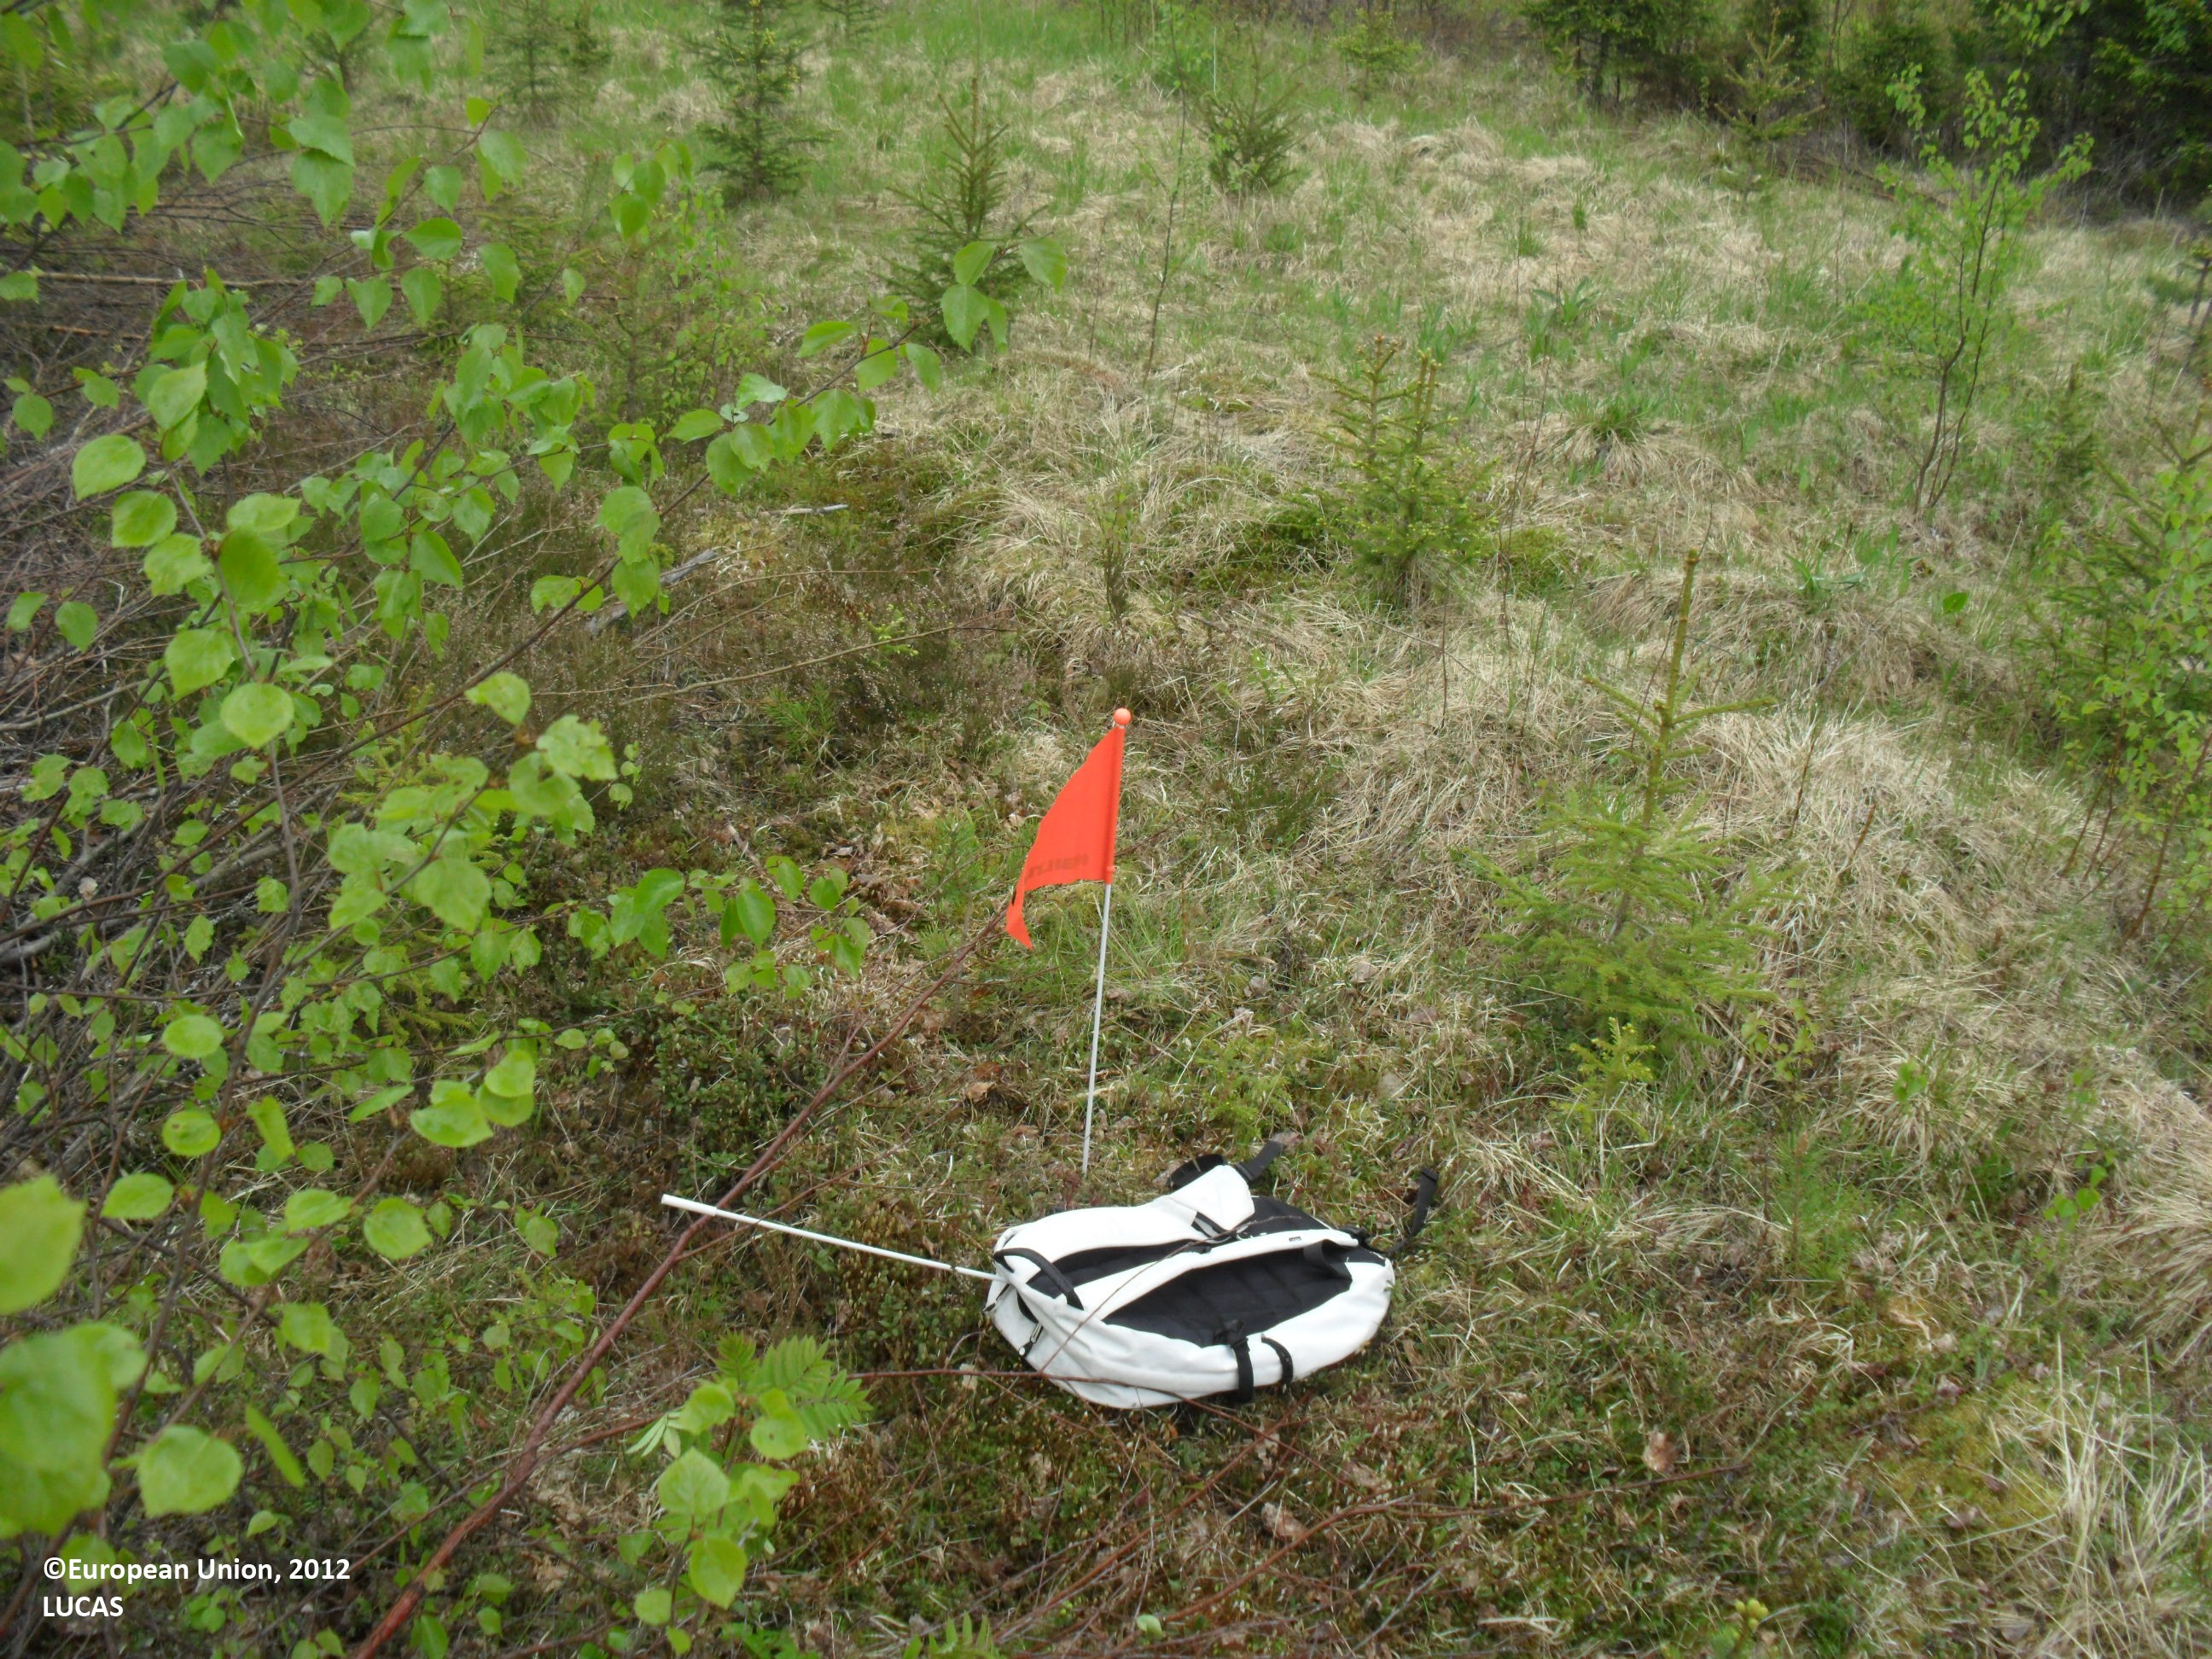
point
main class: Grassland
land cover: Grassland with sparse tree/shrub cover
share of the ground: 10 - 25 %
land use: Semi-natural and natural areas not in use
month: June
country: FI
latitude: 63.0358
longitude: 23.2072
